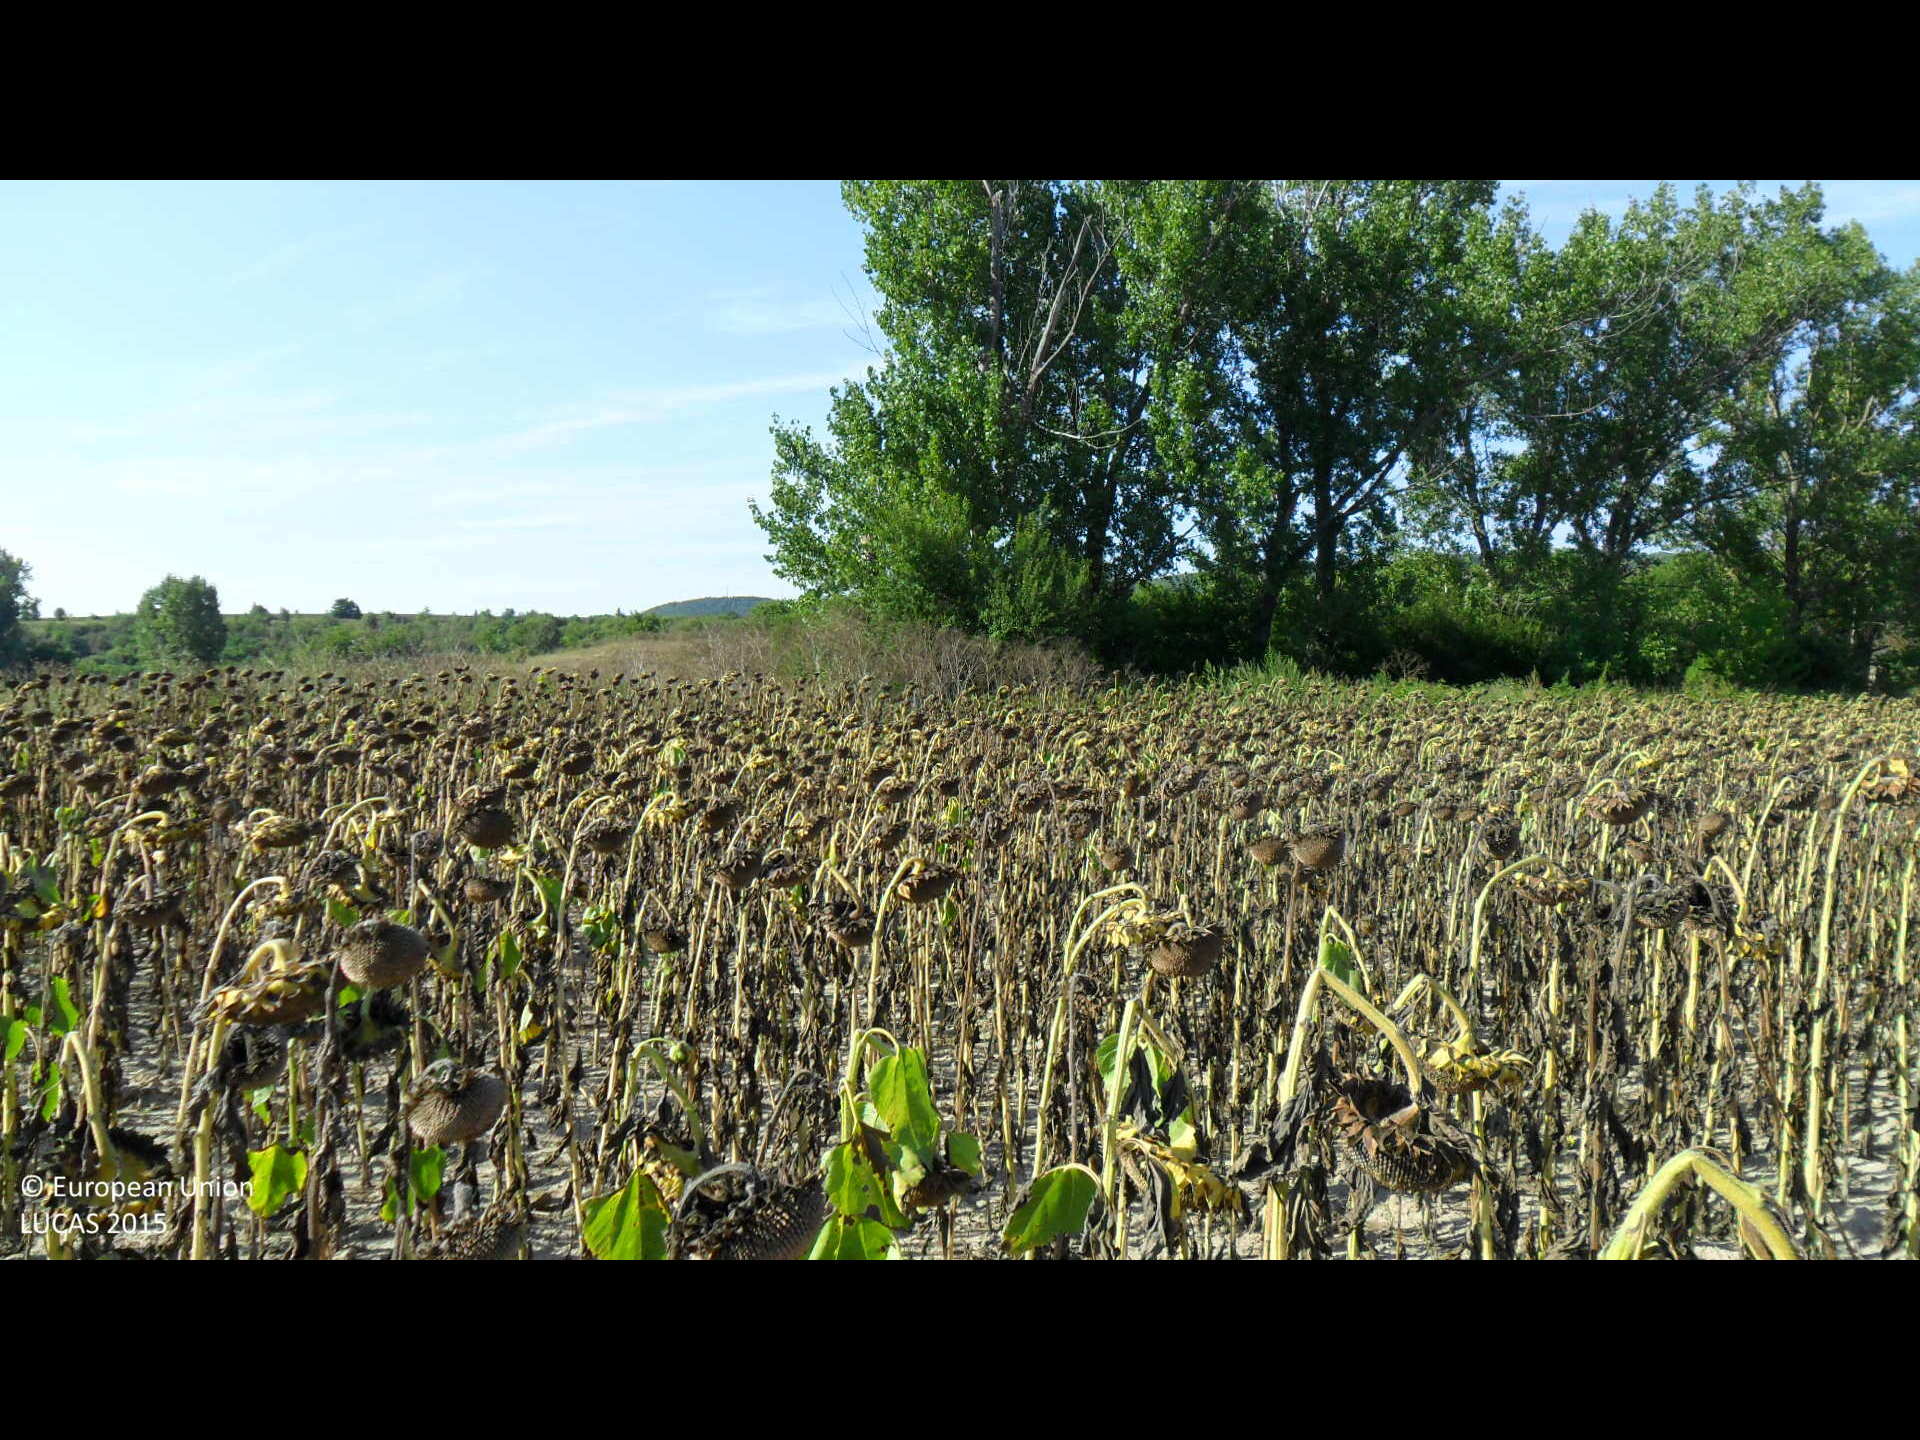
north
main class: Cropland
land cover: Sunflower
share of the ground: > 75 %
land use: Agriculture (excluding fallow land and kitchen gardens)
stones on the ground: < 10 %
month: August
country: BG
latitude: 43.4728
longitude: 26.3061
